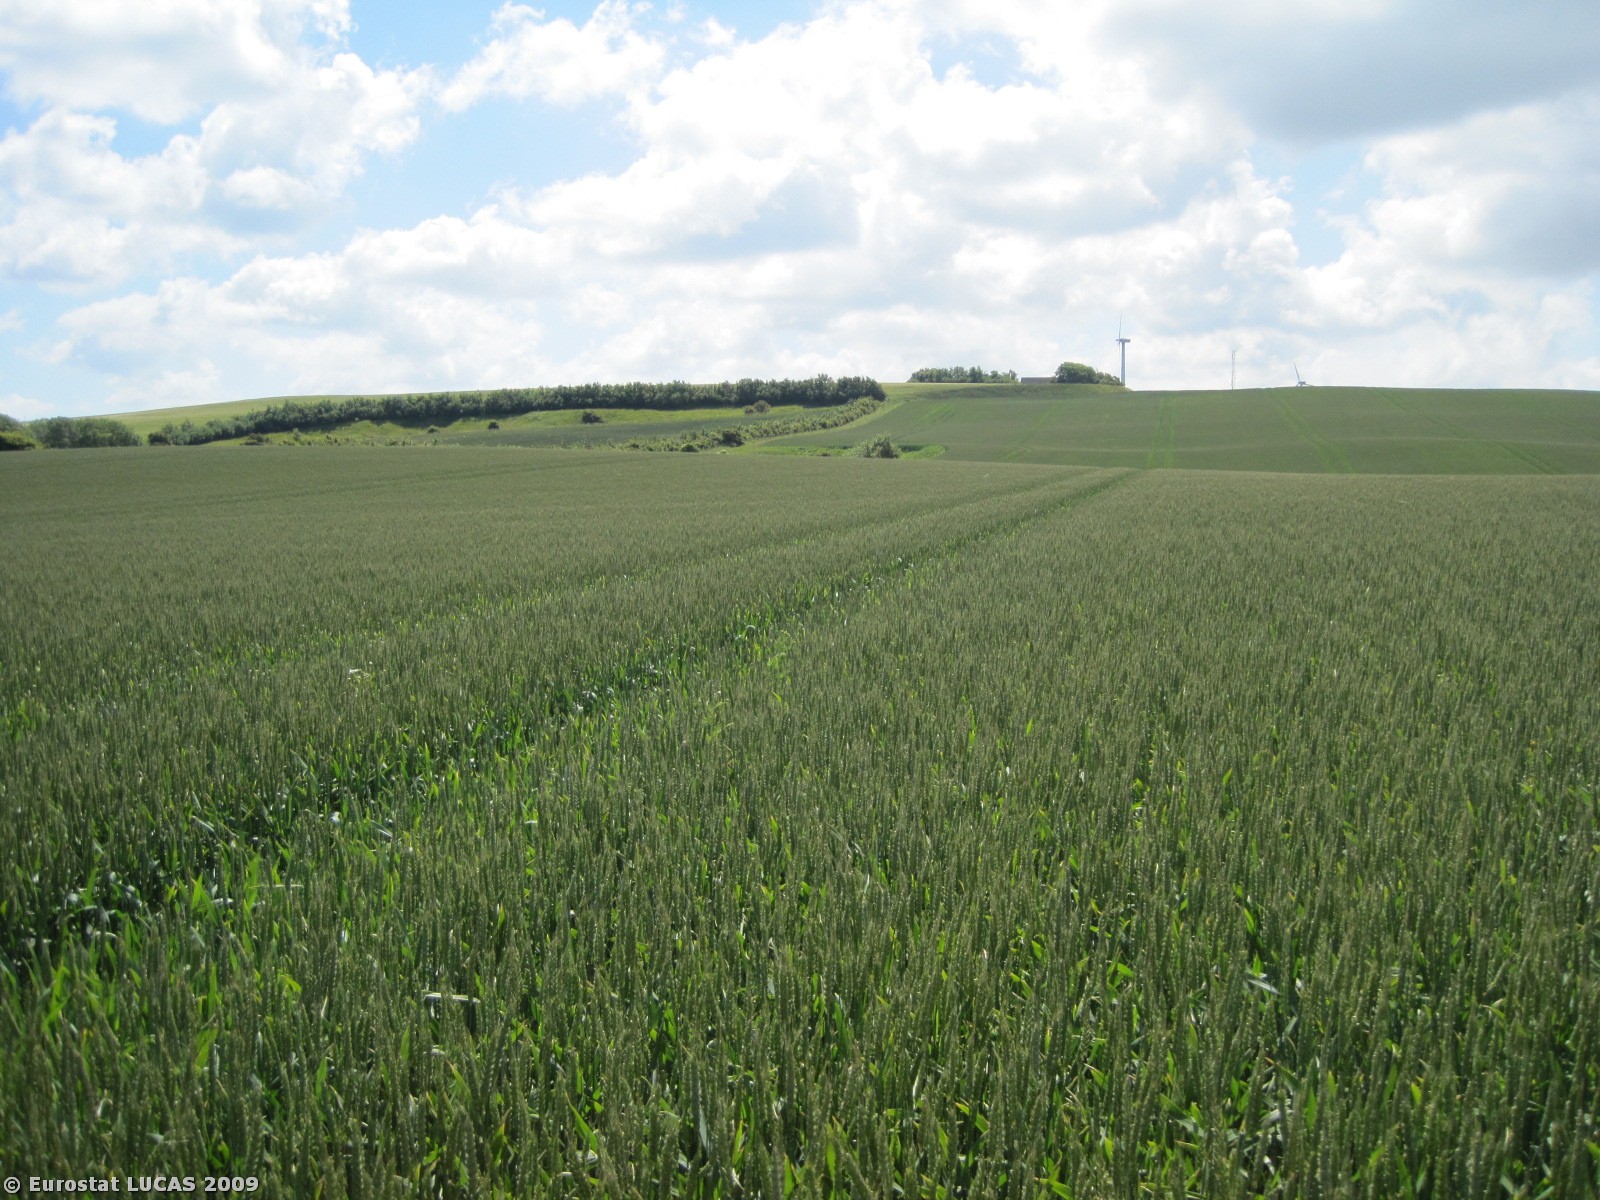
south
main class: Cropland
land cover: Common wheat
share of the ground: > 75 %
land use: Agriculture (excluding fallow land and kitchen gardens)
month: June
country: DK
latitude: 56.8824
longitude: 8.7054
